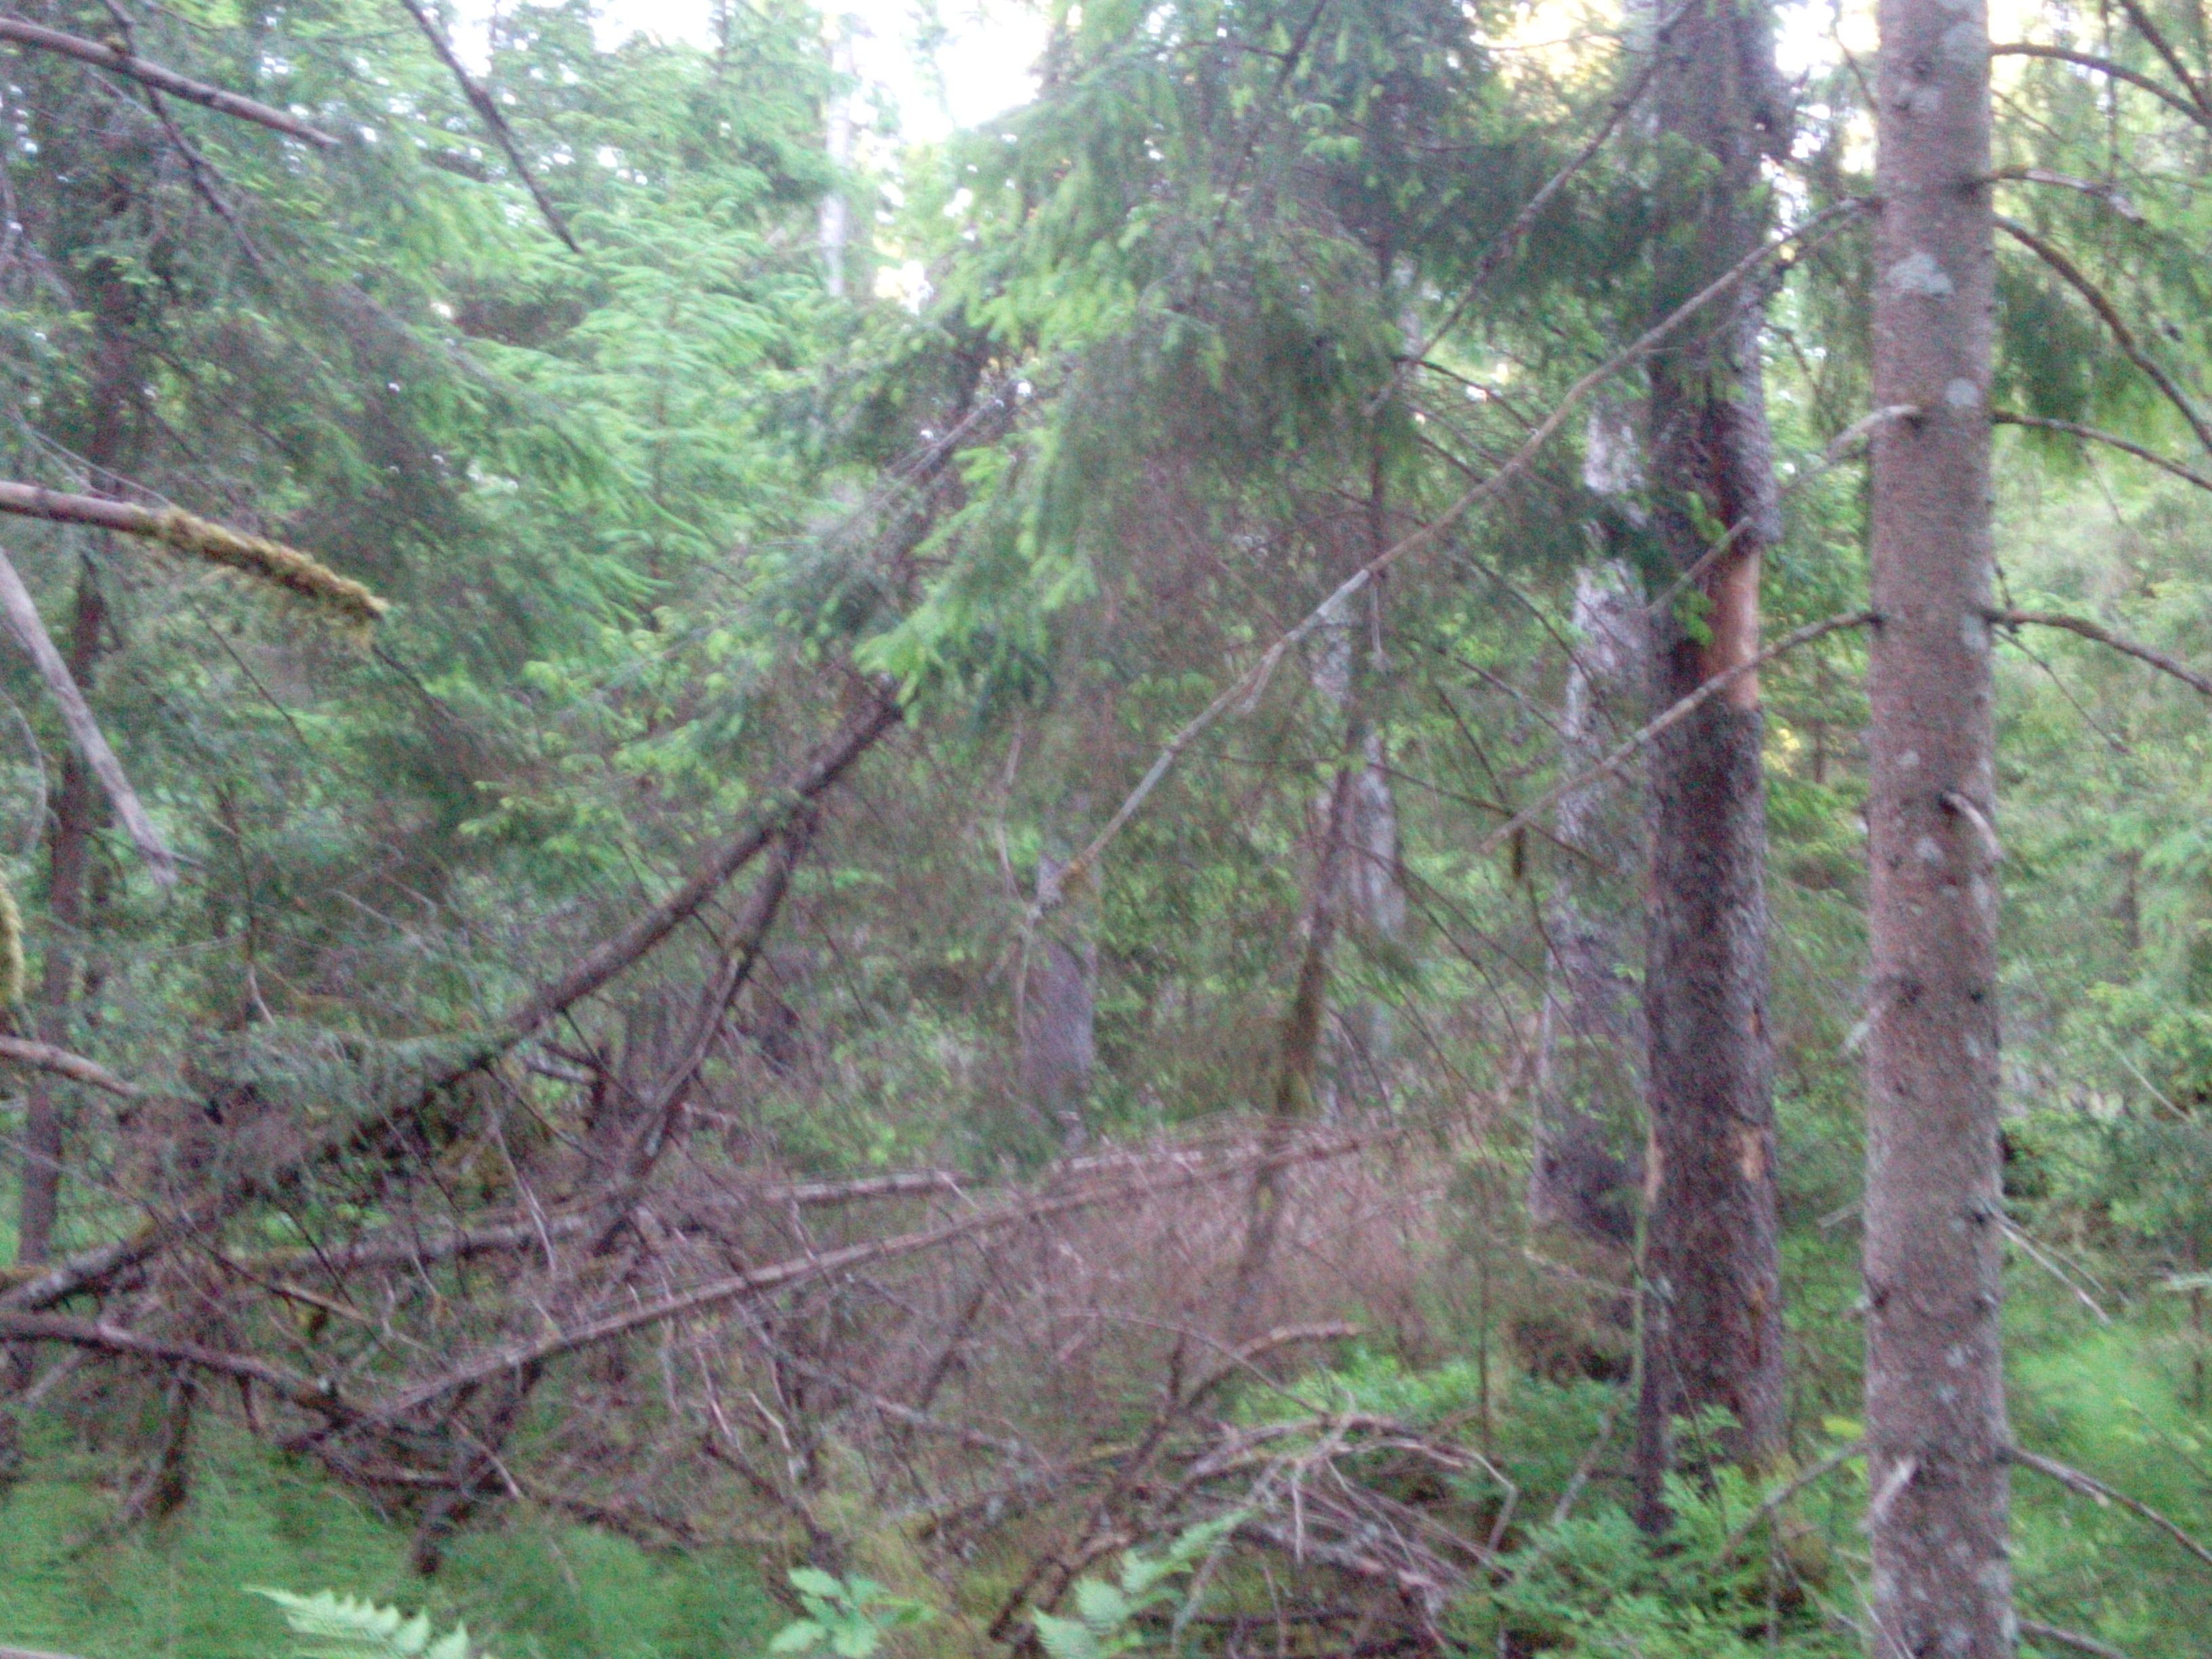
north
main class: Woodland
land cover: Spruce dominated coniferous woodland
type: hemiboreal forest and nemoral coniferous forest and mixed broadleaved-coniferous forest
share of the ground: > 75 %
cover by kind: coniferous forest trees 85 %, broadleaved forest trees 5 %, herbaceous plants 5 %, lichens and mosses 5 %
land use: Forestry
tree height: > 5 m
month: June
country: LV
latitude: 56.7531
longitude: 22.1696
